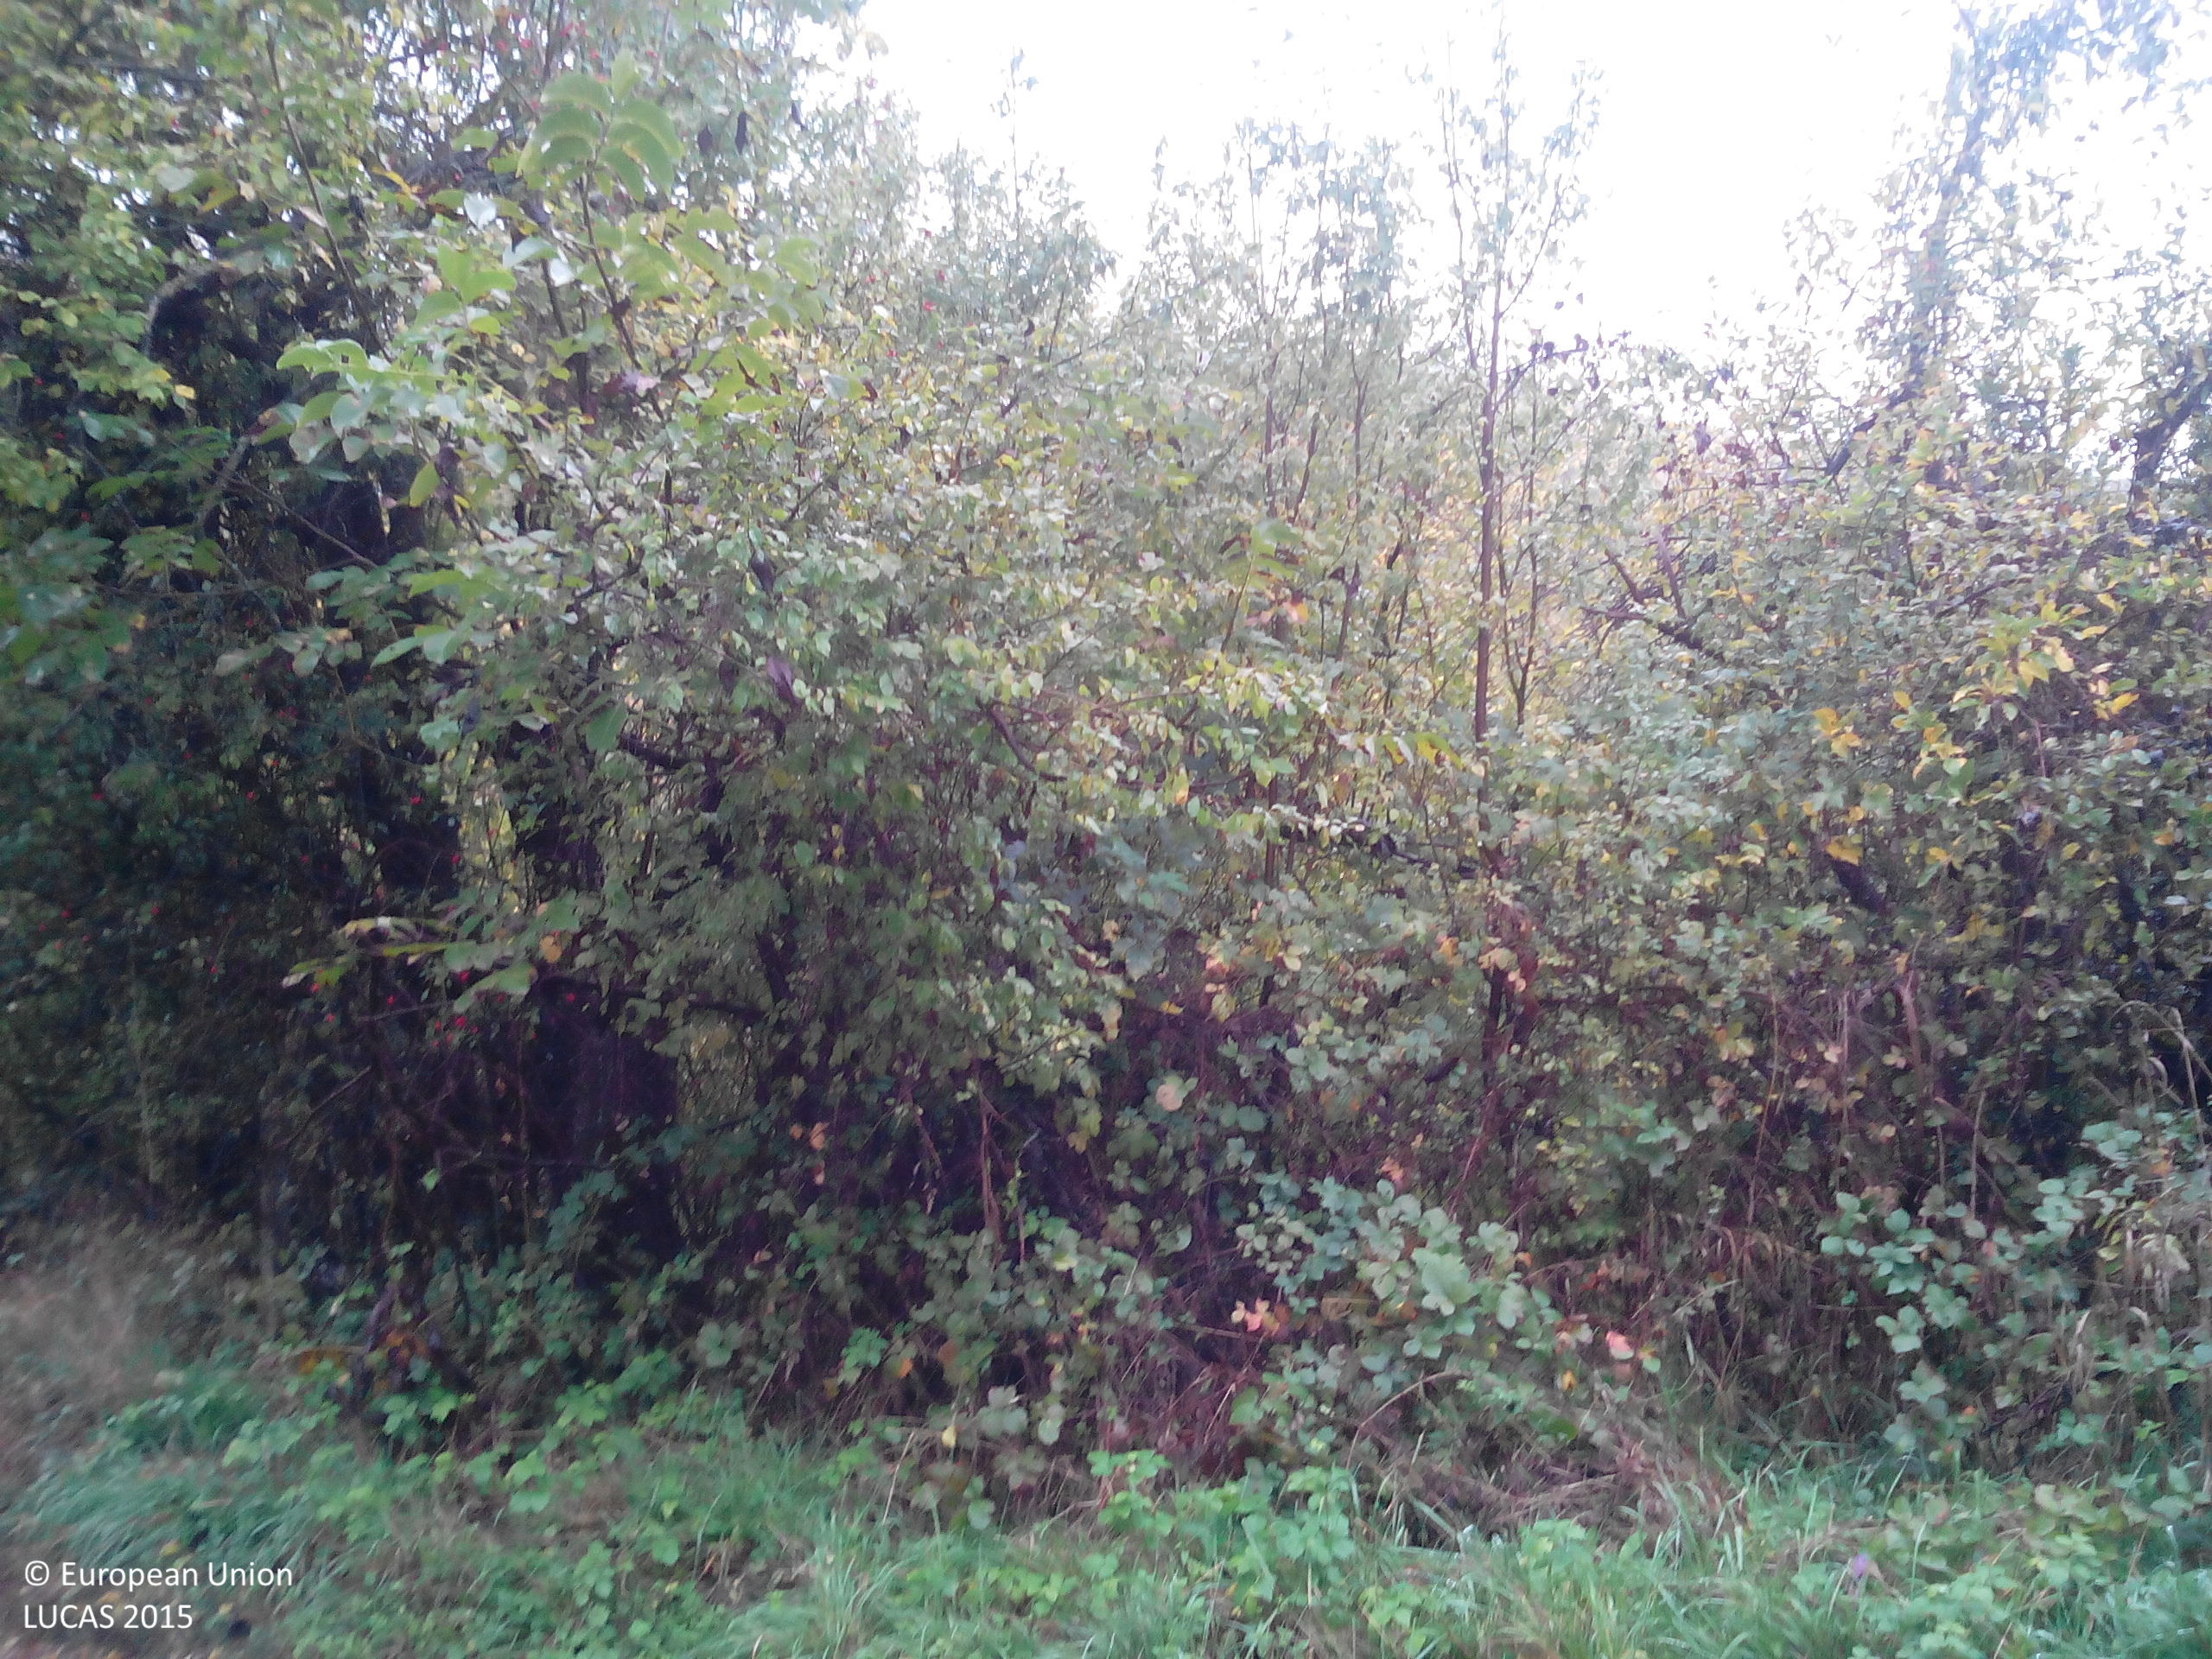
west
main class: Woodland
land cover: Broadleaved woodland
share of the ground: > 75 %
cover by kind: broadleaved forest trees 90 %, shrubs 5 %, herbaceous plants 5 %
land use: Abandoned areas
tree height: > 5 m
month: October
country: BG
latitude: 43.0036
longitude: 24.3204
